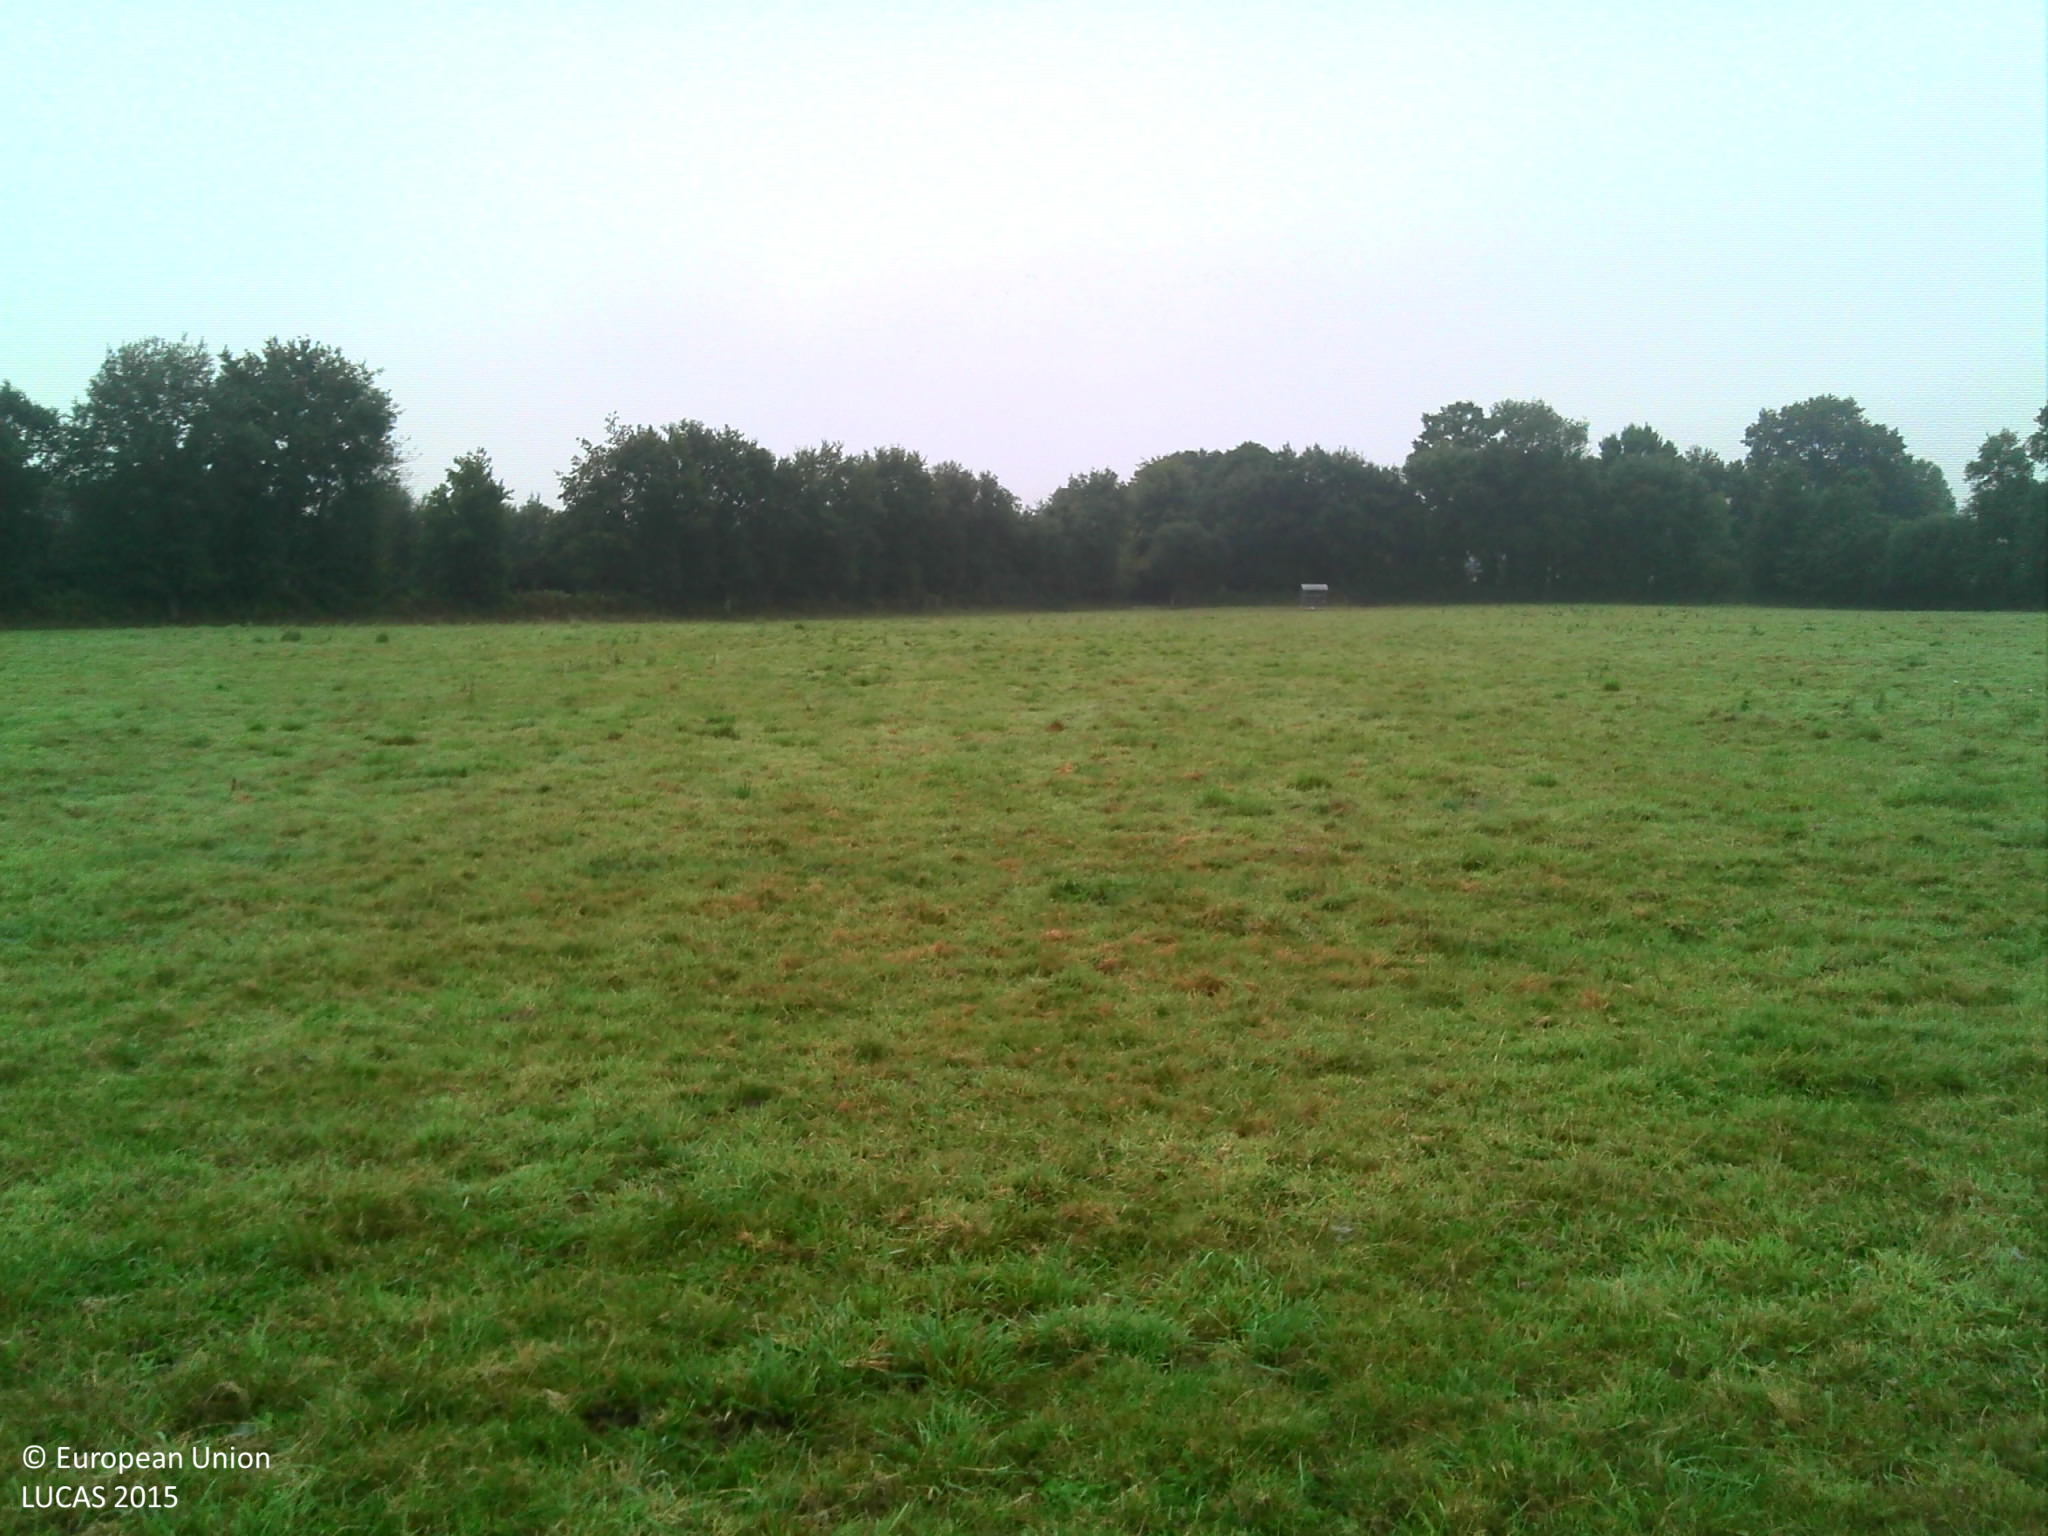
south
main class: Grassland
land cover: Grassland without tree/shrub cover
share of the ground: > 75 %
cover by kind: herbaceous plants 100 %
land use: Agriculture (excluding fallow land and kitchen gardens)
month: October
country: FR
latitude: 47.9434
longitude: -2.3607
